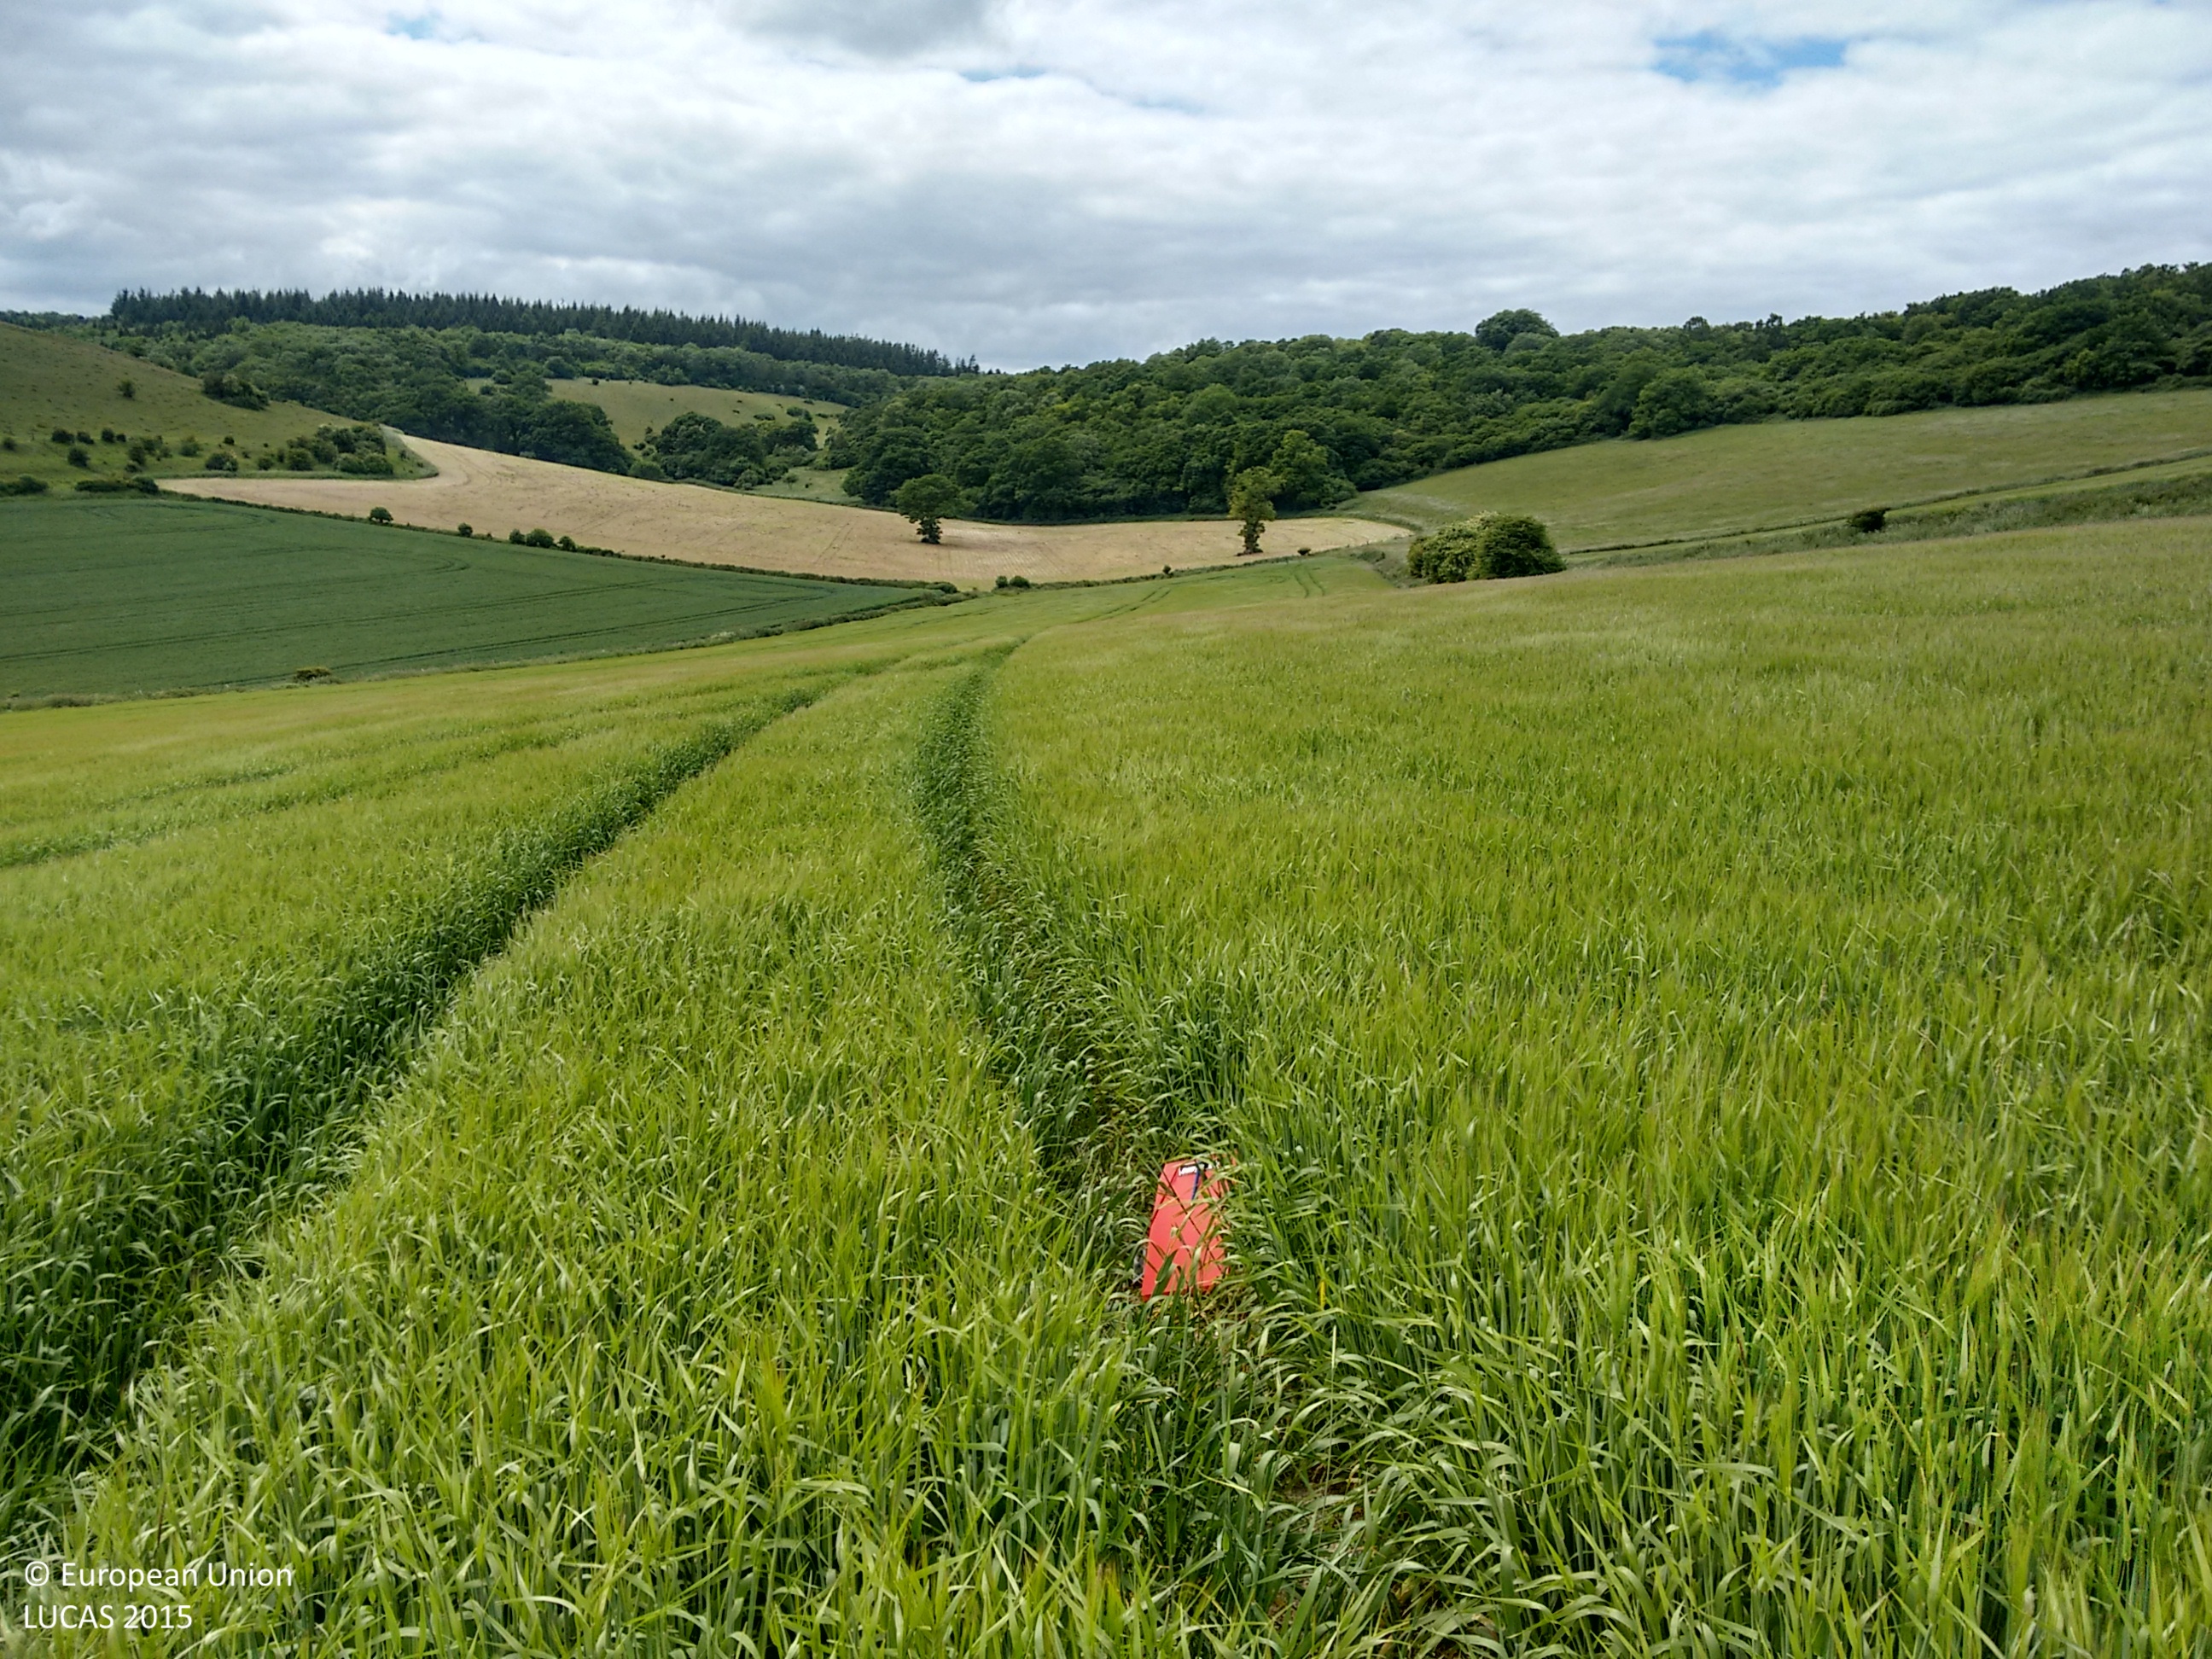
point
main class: Cropland
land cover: Barley
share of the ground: > 75 %
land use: Agriculture (excluding fallow land and kitchen gardens)
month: June
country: GB
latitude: 51.1188
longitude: -1.9293
